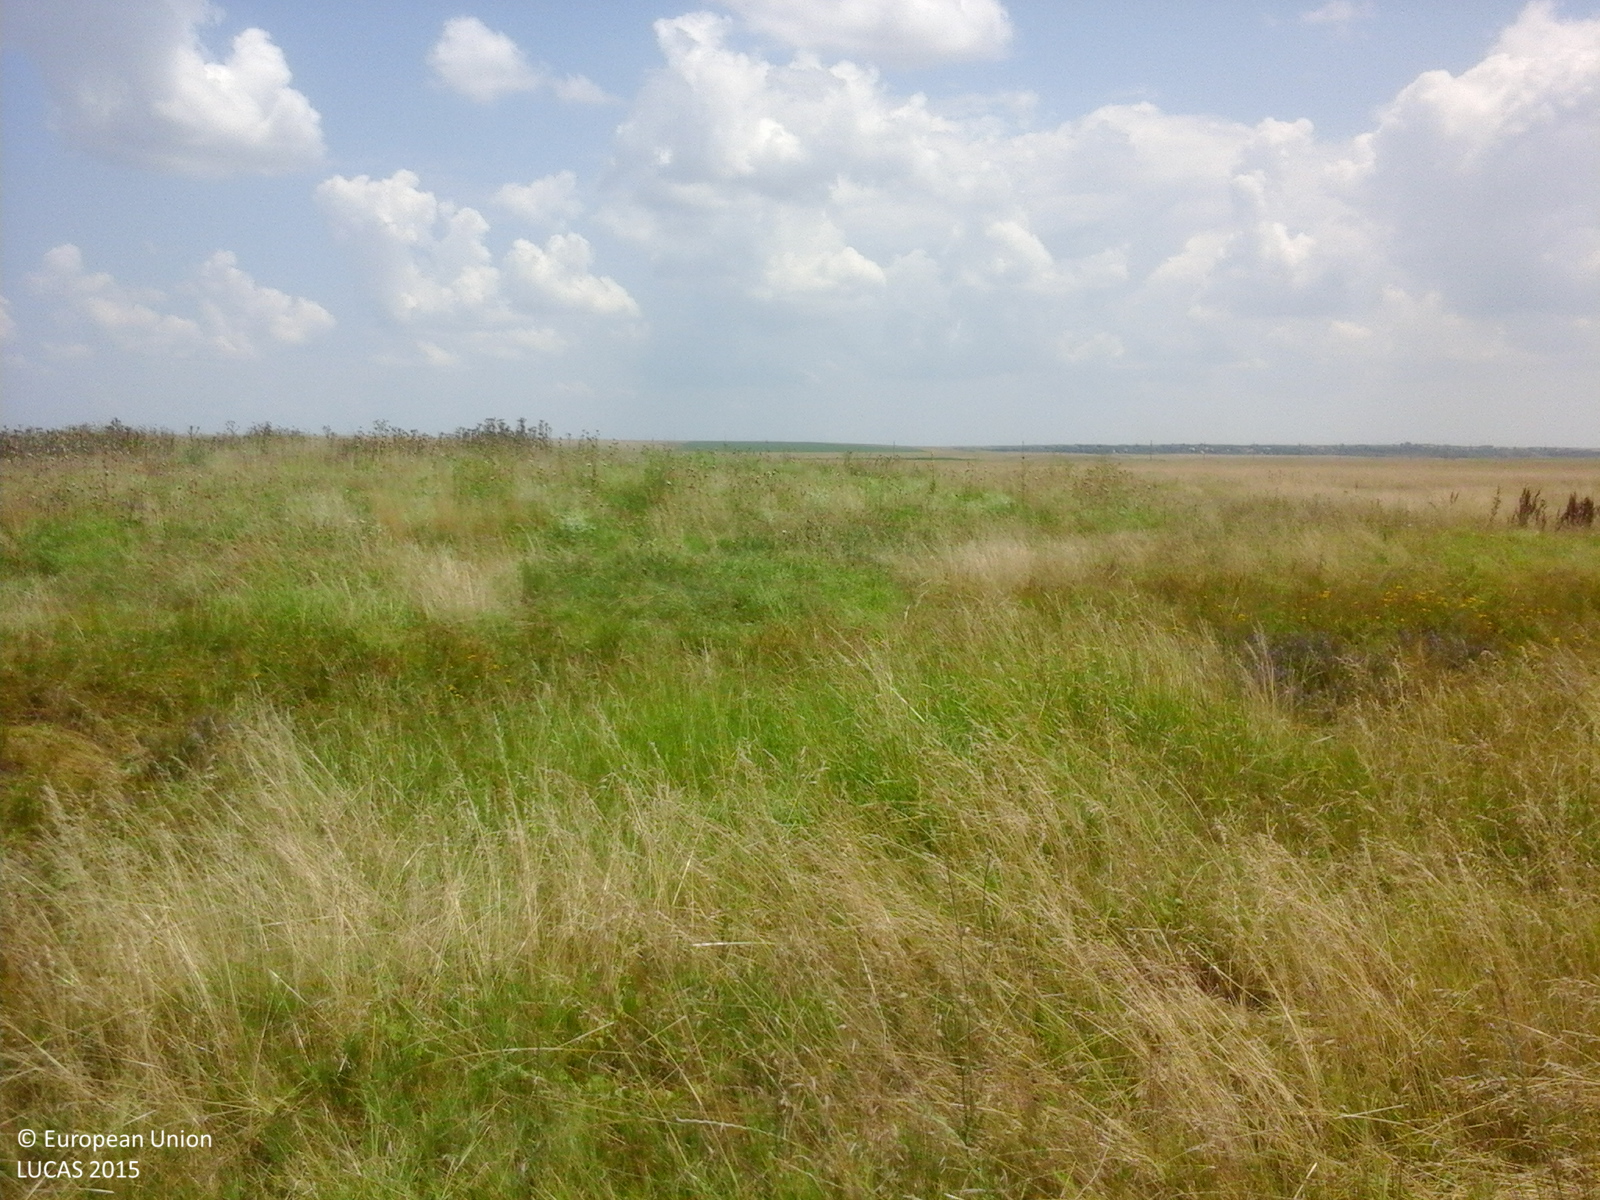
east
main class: Grassland
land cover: Grassland without tree/shrub cover
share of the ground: > 75 %
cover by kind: herbaceous plants 100 %
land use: Agriculture (excluding fallow land and kitchen gardens)
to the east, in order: Grassland without tree/shrub cover; Common wheat
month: July
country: RO
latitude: 44.0441
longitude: 25.3471
